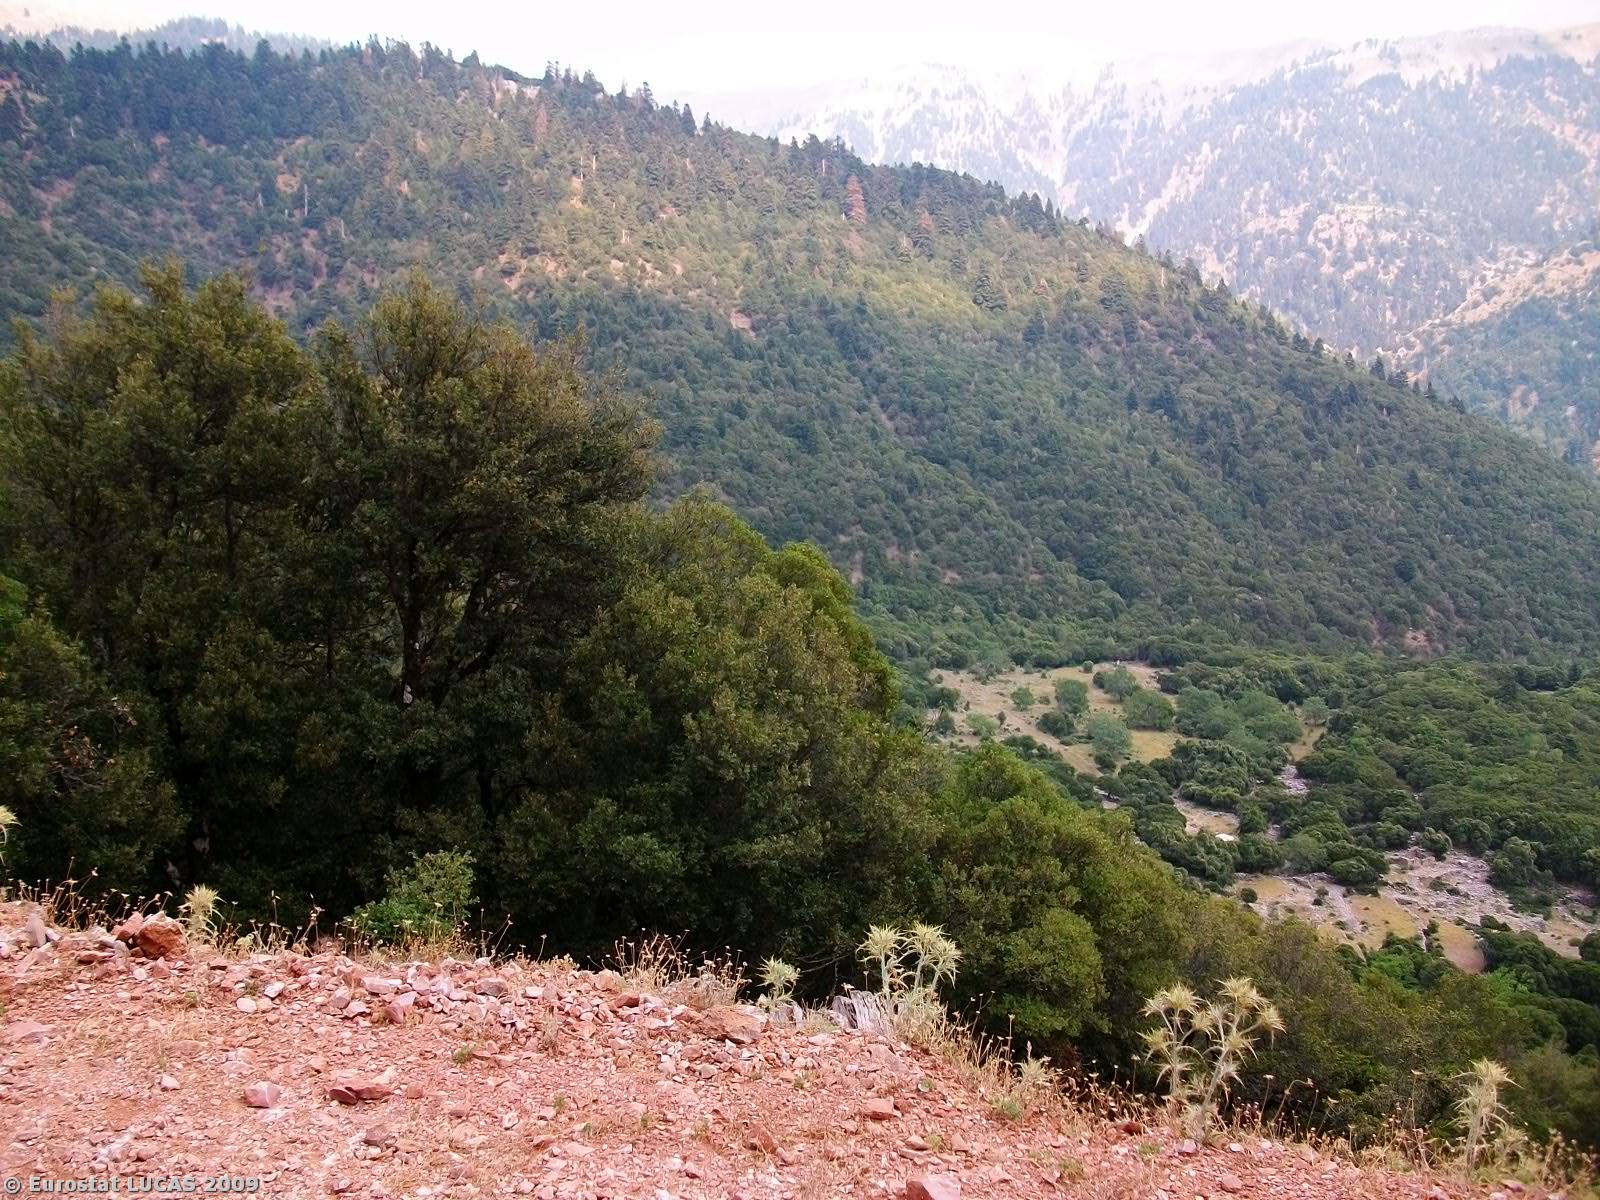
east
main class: Woodland
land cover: Broadleaved woodland
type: broadleaved evergreen forest
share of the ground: > 75 %
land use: Forestry
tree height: > 5 m
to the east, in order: Broadleaved woodland; Tracks; Mixed woodland; Rivers and streams; Mixed woodland
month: August
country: GR
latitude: 38.7235
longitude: 21.5546
